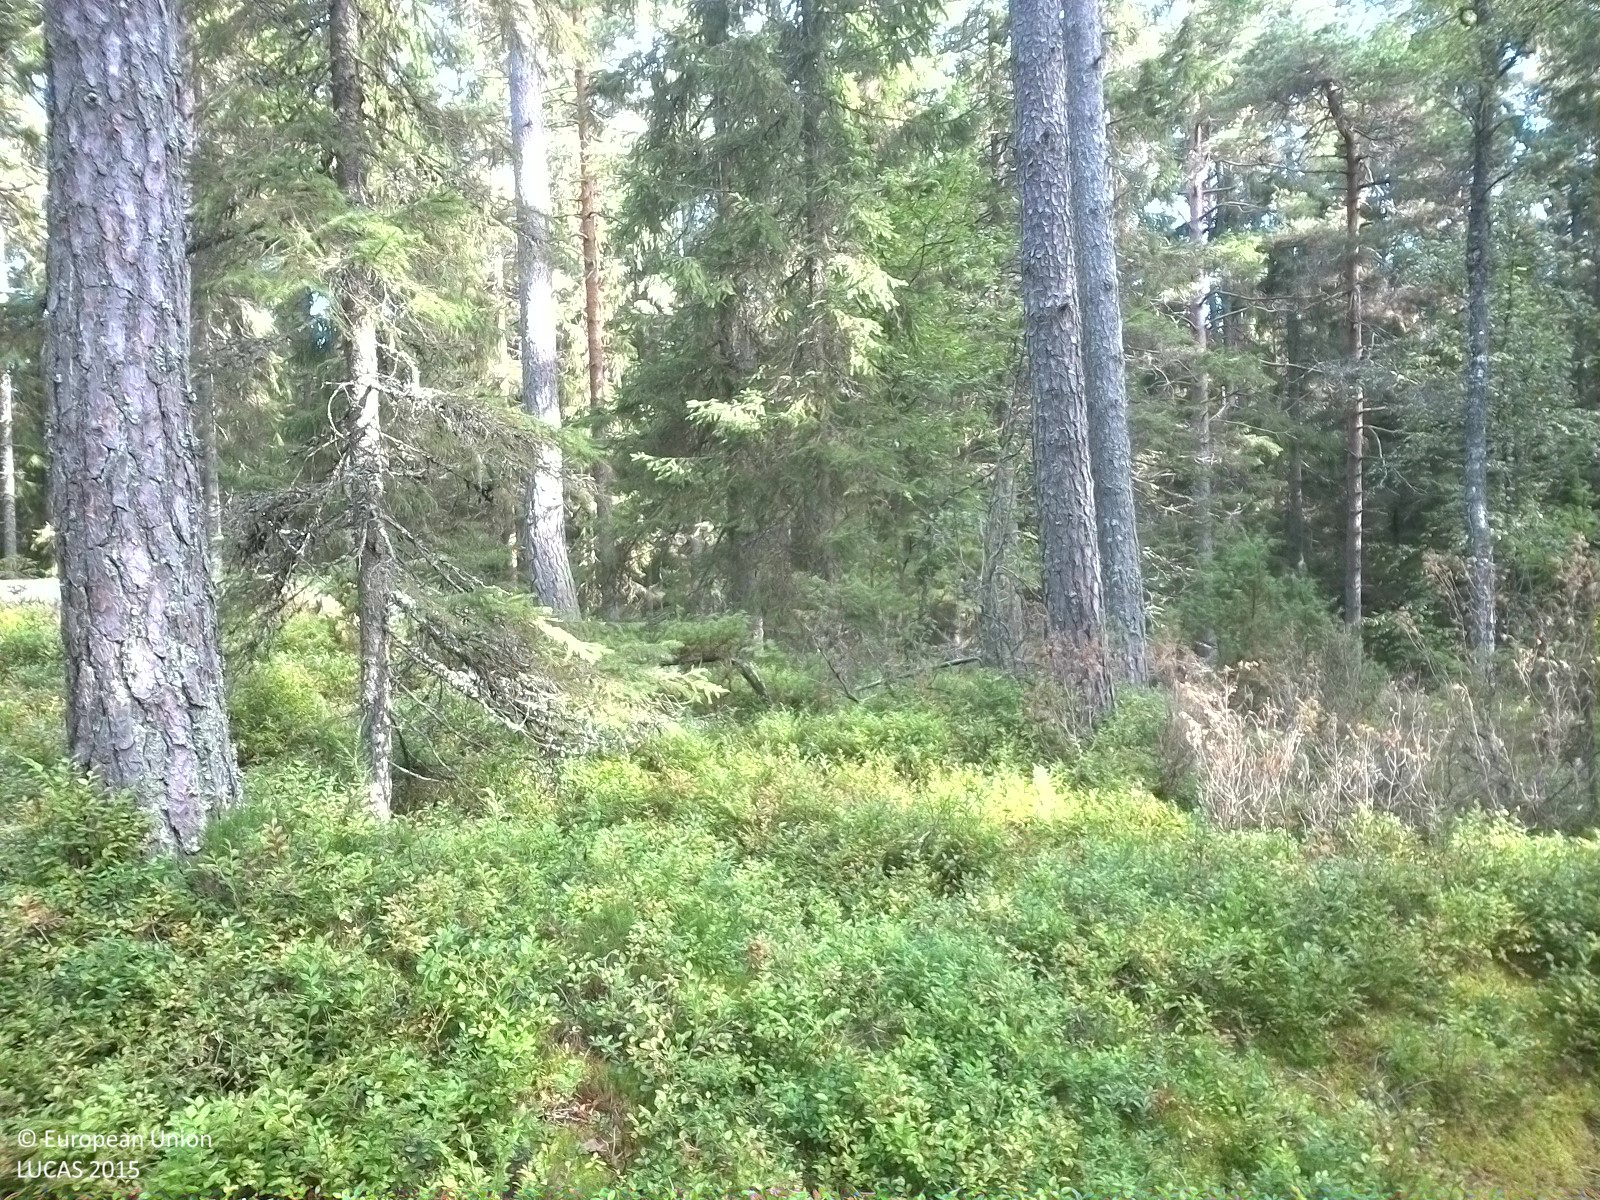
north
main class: Woodland
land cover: Pine dominated coniferous woodland
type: boreal forest
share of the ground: 25 - 50 %
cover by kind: shrubs 60 %, coniferous forest trees 25 %, herbaceous plants 10 %, lichens and mosses 5 %
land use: Forestry
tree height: > 5 m
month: August
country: SE
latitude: 58.7195
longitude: 15.0524
